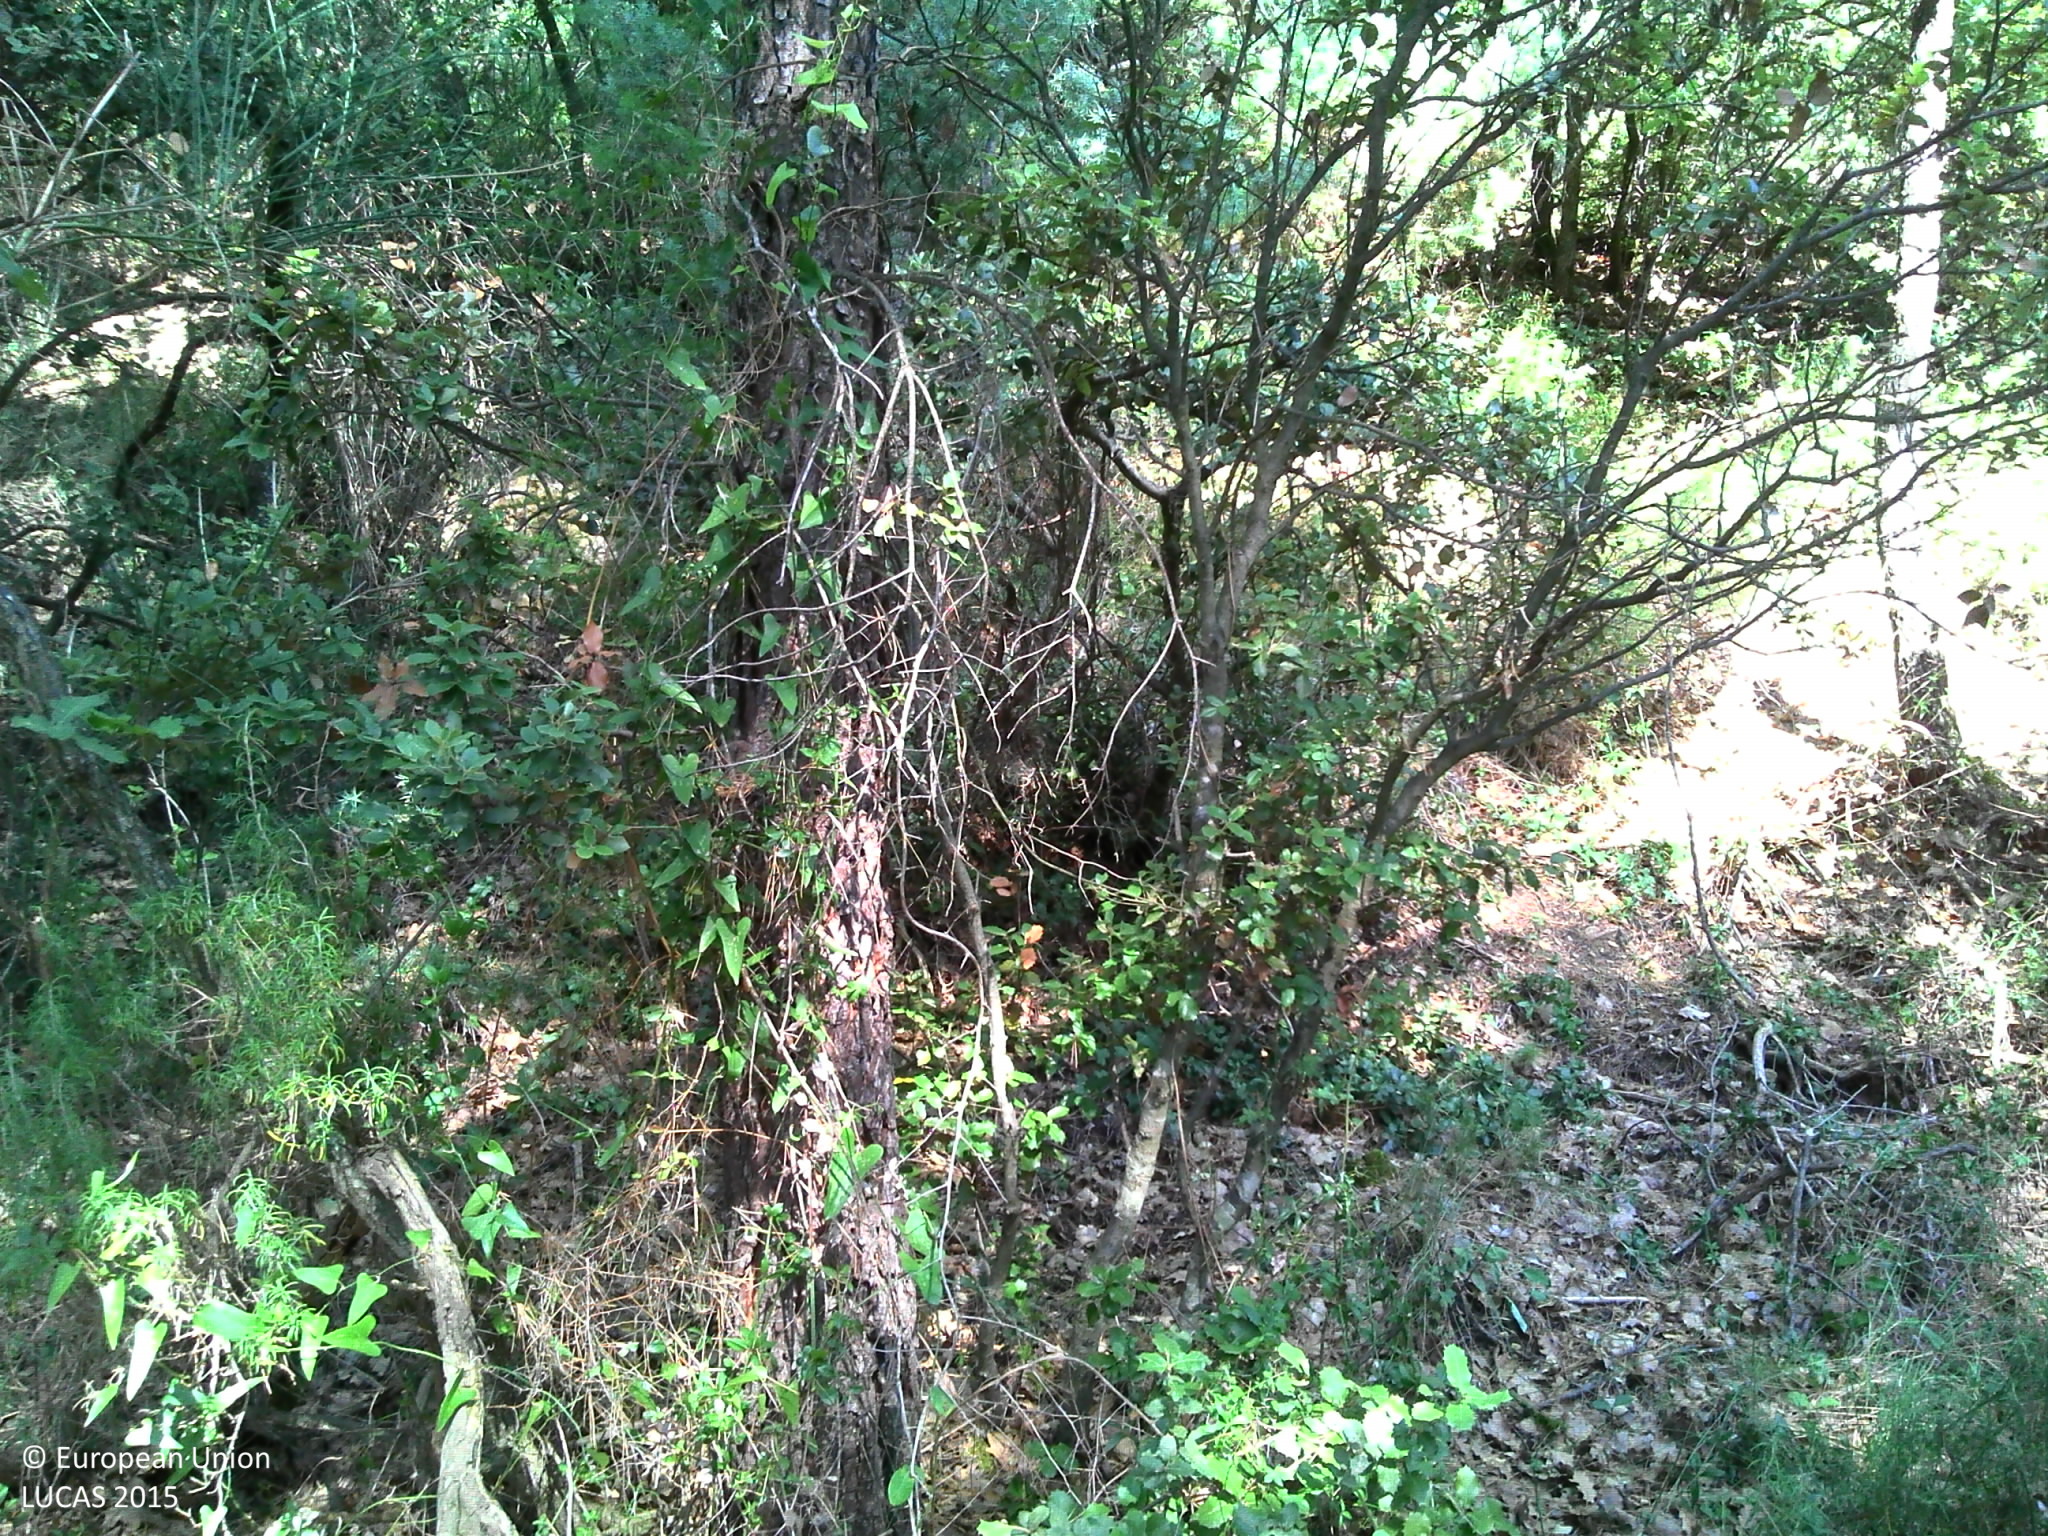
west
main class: Woodland
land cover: Pine dominated mixed woodland
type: mesophytic deciduous forest
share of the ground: > 75 %
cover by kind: coniferous forest trees 40 %, broadleaved forest trees 30 %, shrubs 10 %, herbaceous plants 10 %, lichens and mosses 10 %
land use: Semi-natural and natural areas not in use
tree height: > 5 m
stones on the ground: < 10 %
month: July
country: FR
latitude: 44.1611
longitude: 5.0686
